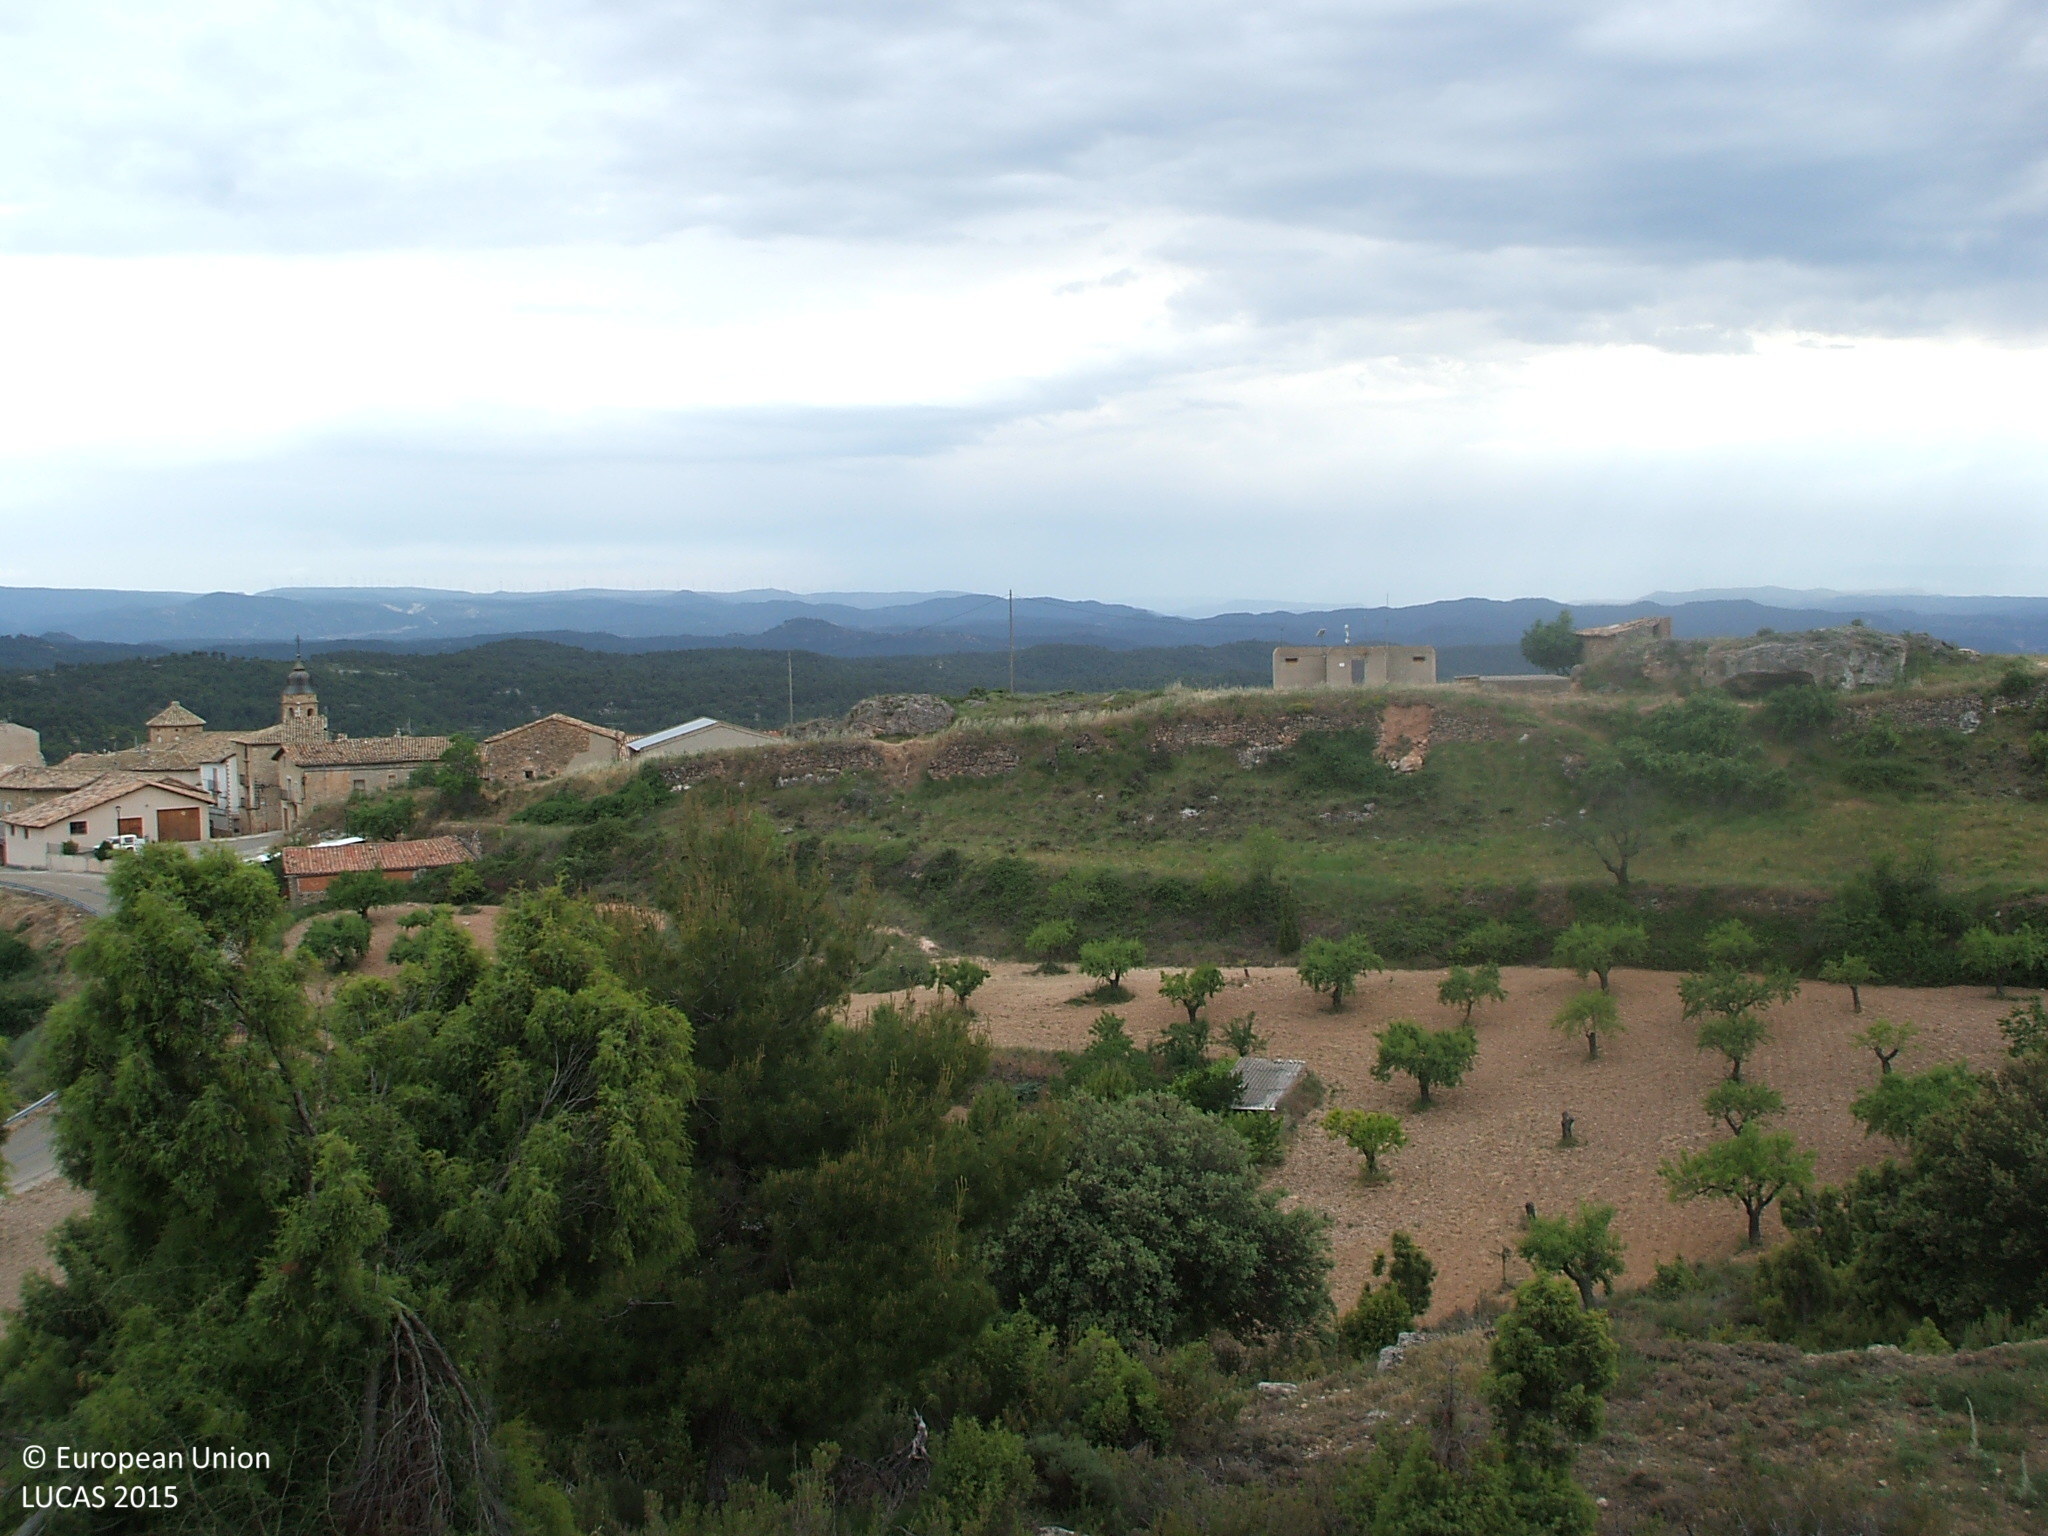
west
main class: Shrubland
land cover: Shrubland with sparse tree cover
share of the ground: 50 - 75 %
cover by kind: consolidated bare surface 55 %, shrubs 40 %, broadleaved forest trees 5 %
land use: Semi-natural and natural areas not in use
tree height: > 5 m
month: June
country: ES
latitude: 40.8424
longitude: -0.0548
